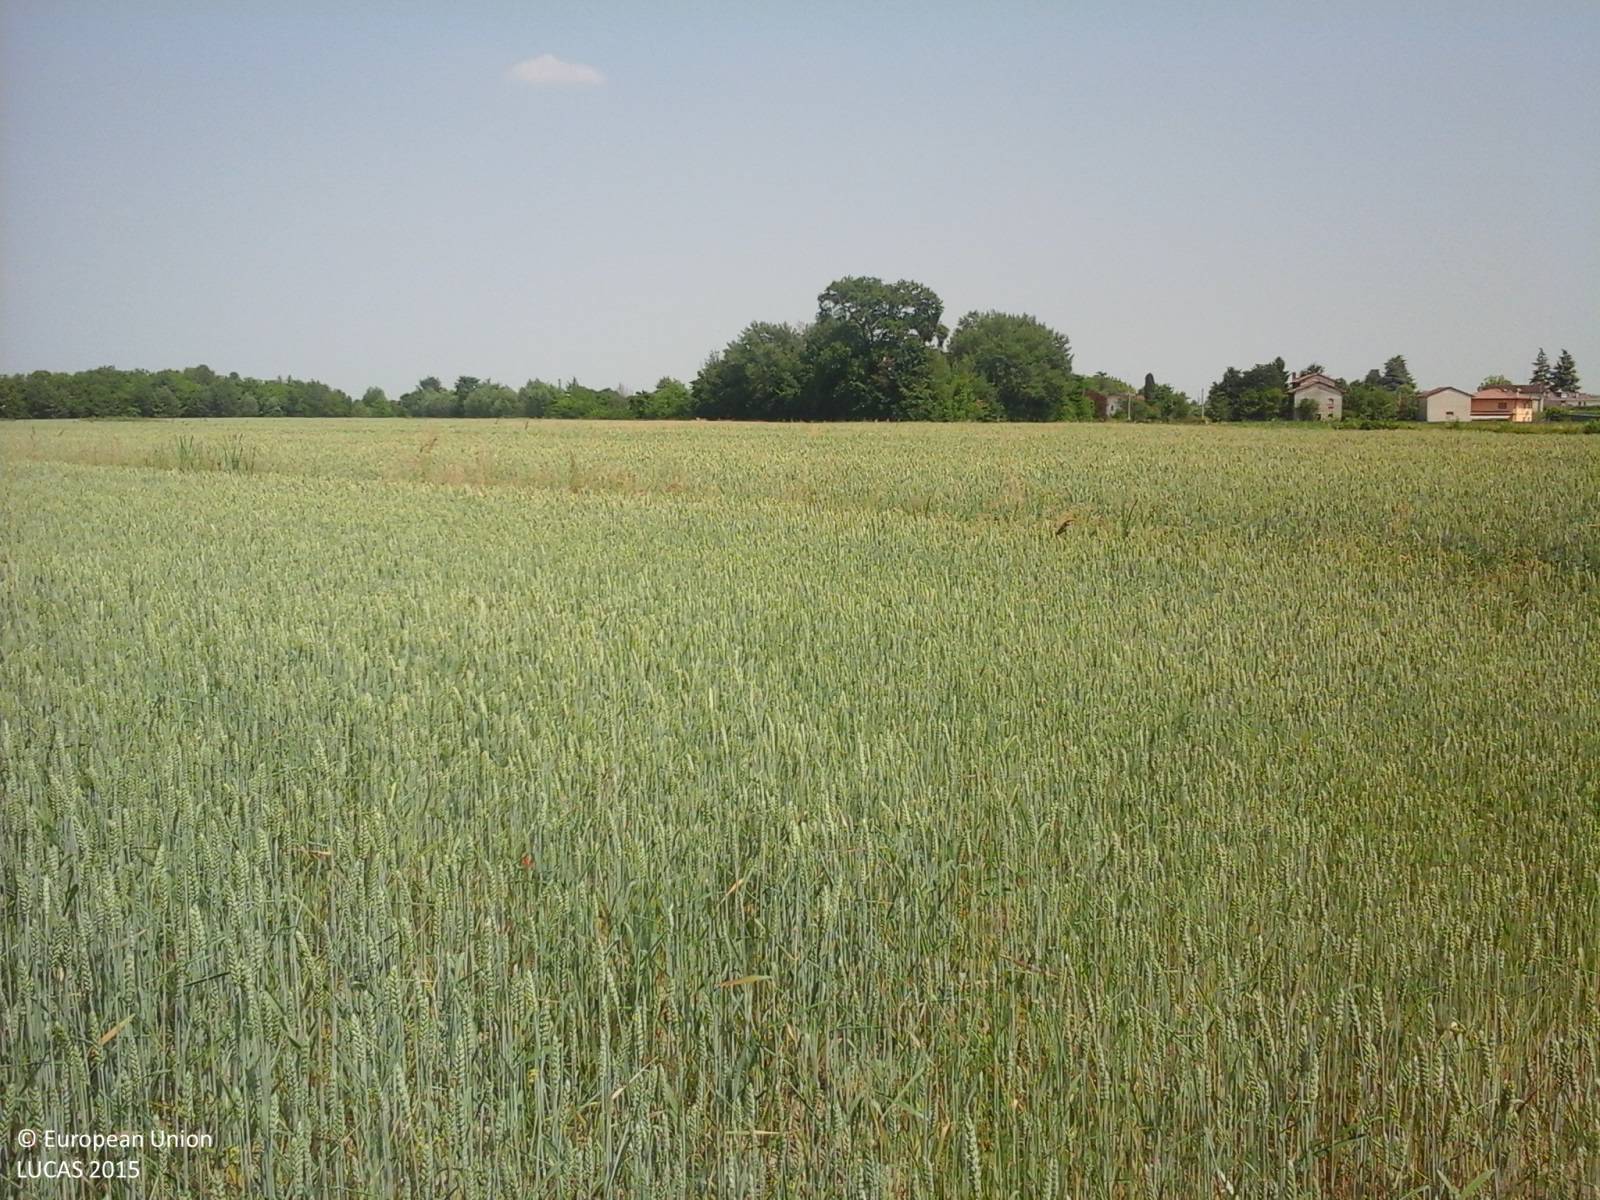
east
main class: Cropland
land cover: Common wheat
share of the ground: > 75 %
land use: Agriculture (excluding fallow land and kitchen gardens)
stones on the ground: < 10 %
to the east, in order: Common wheat; Ditches and canals; Common wheat; Ditches and canals; Common wheat; Ditches and canals; Common wheat; Ditches and canals; Common wheat; Ditches and canals; Common wheat
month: June
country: IT
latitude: 45.8886
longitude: 12.5353
